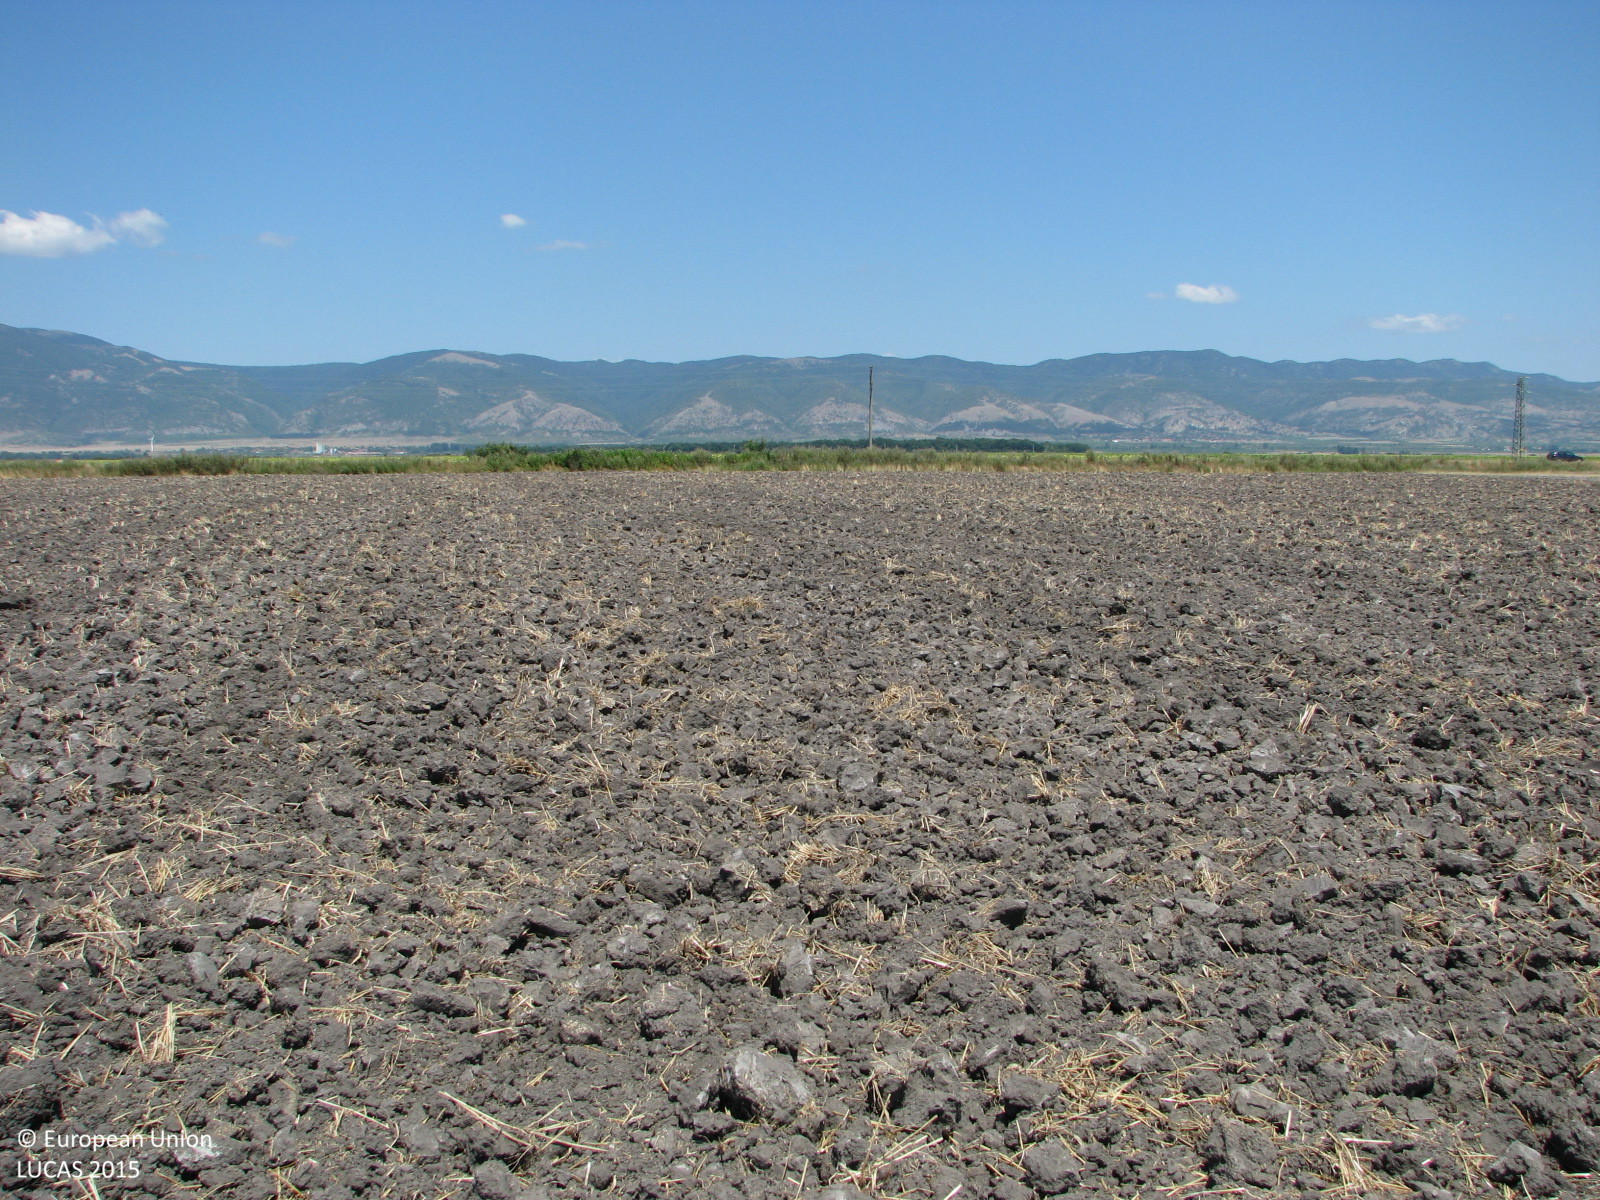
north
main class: Cropland
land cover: Common wheat
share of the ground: < 10 %
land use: Agriculture (excluding fallow land and kitchen gardens)
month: July
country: BG
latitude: 42.6020
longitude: 26.4617
